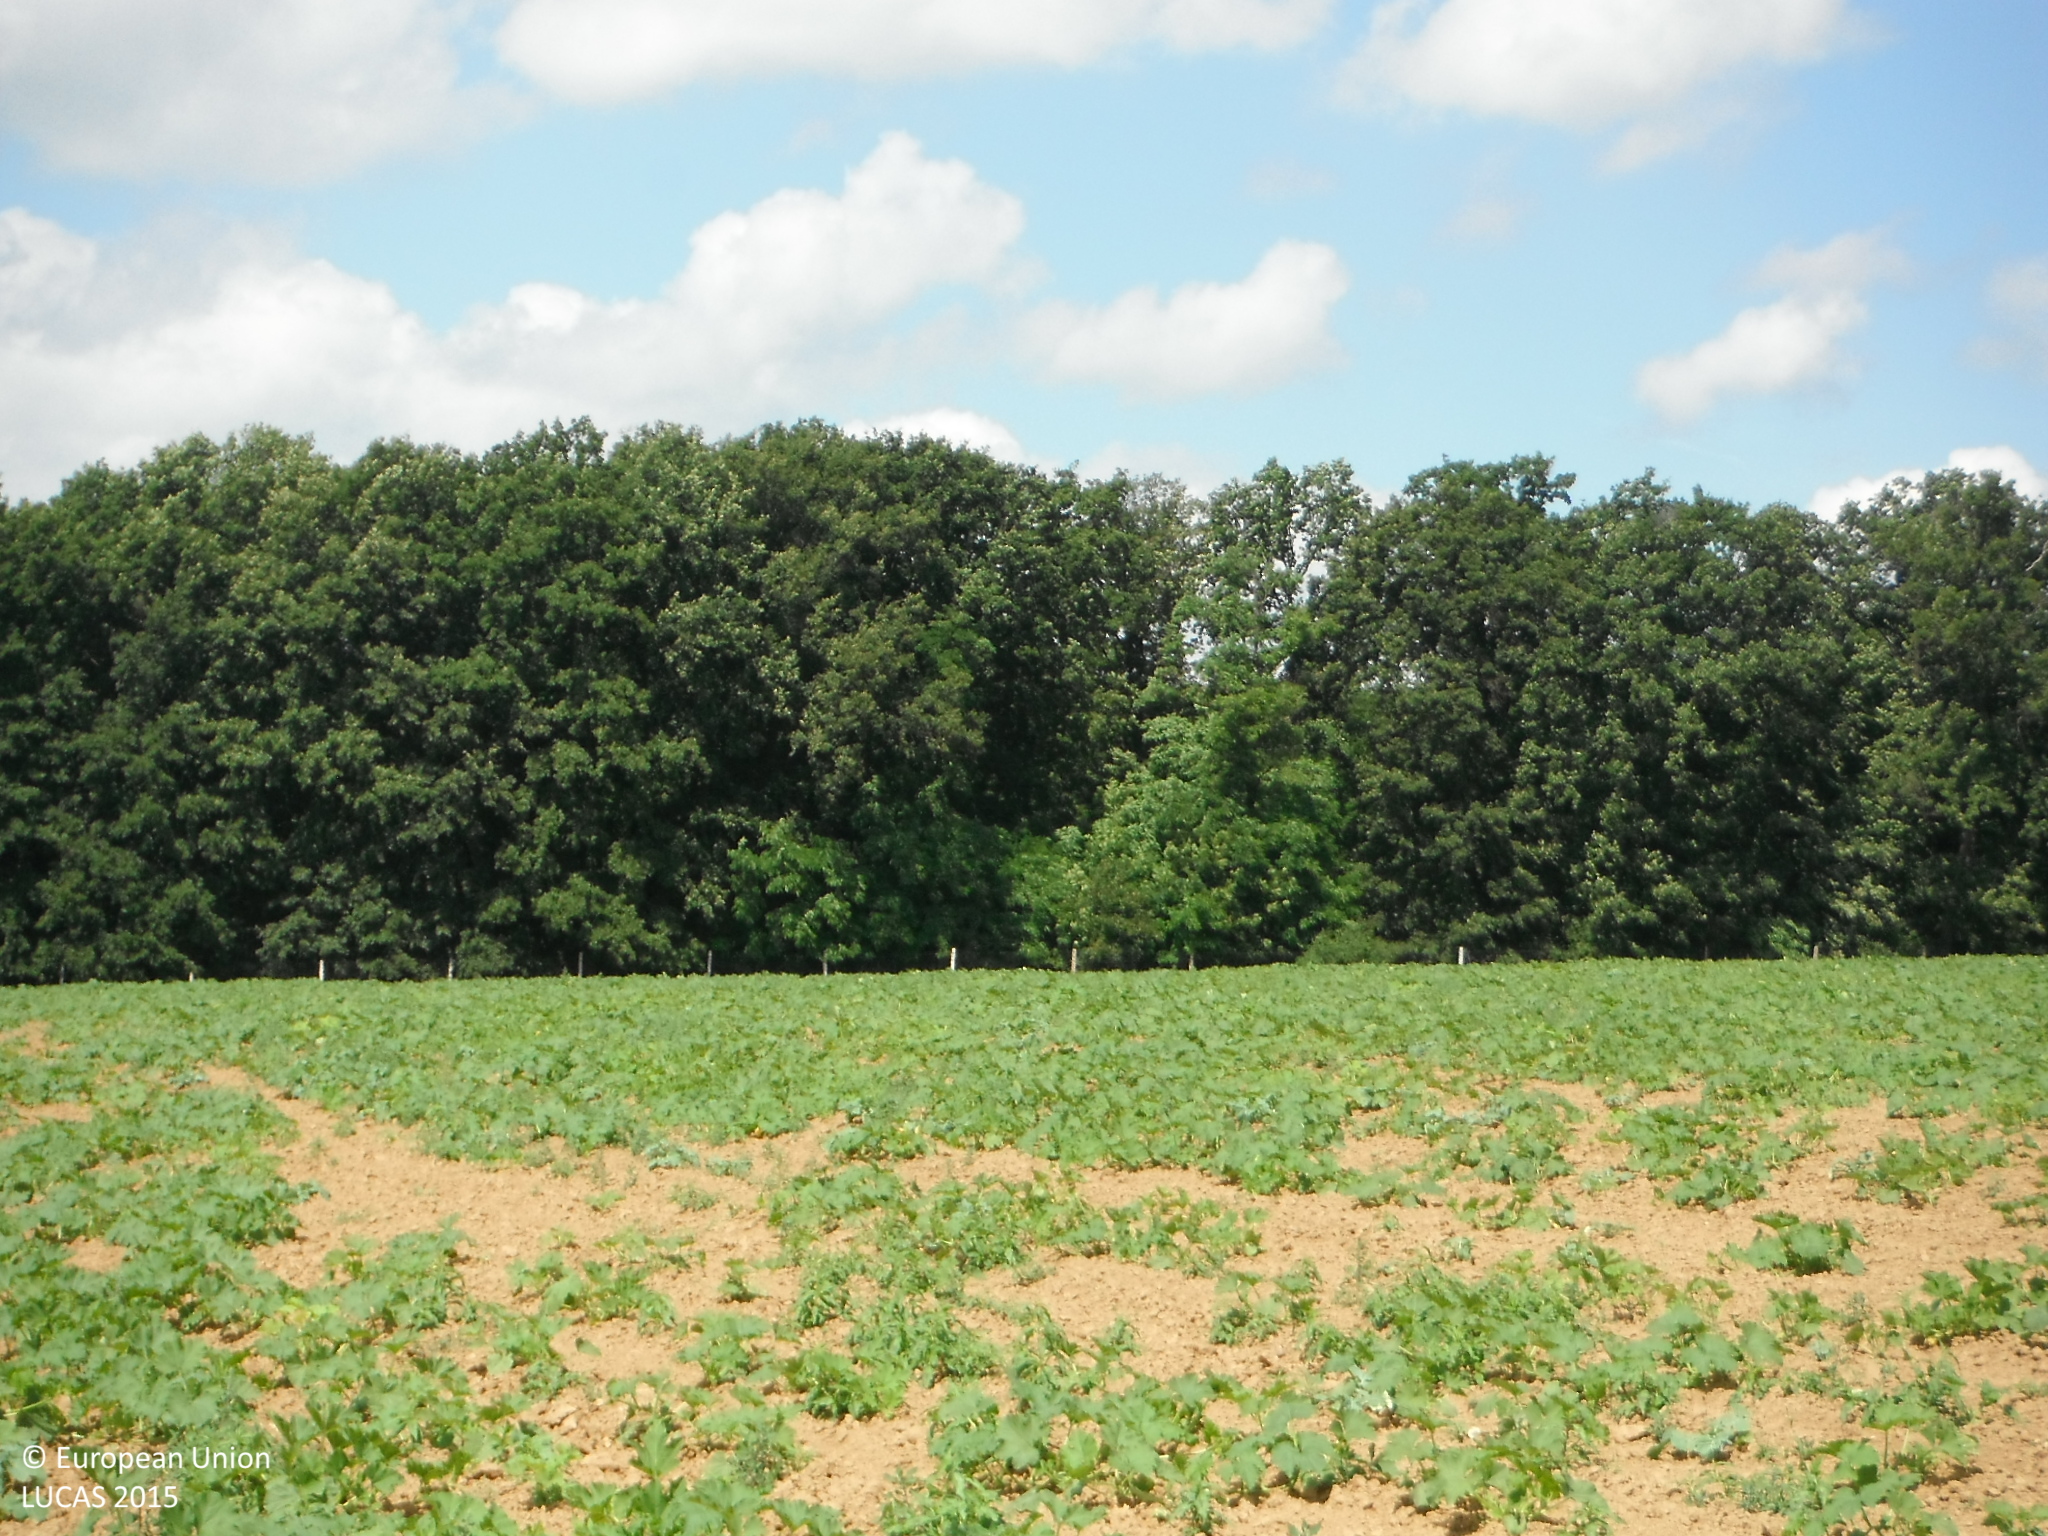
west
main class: Cropland
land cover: Other fresh vegetables
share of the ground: 25 - 50 %
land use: Agriculture (excluding fallow land and kitchen gardens)
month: June
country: SK
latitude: 48.3989
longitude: 18.2949
